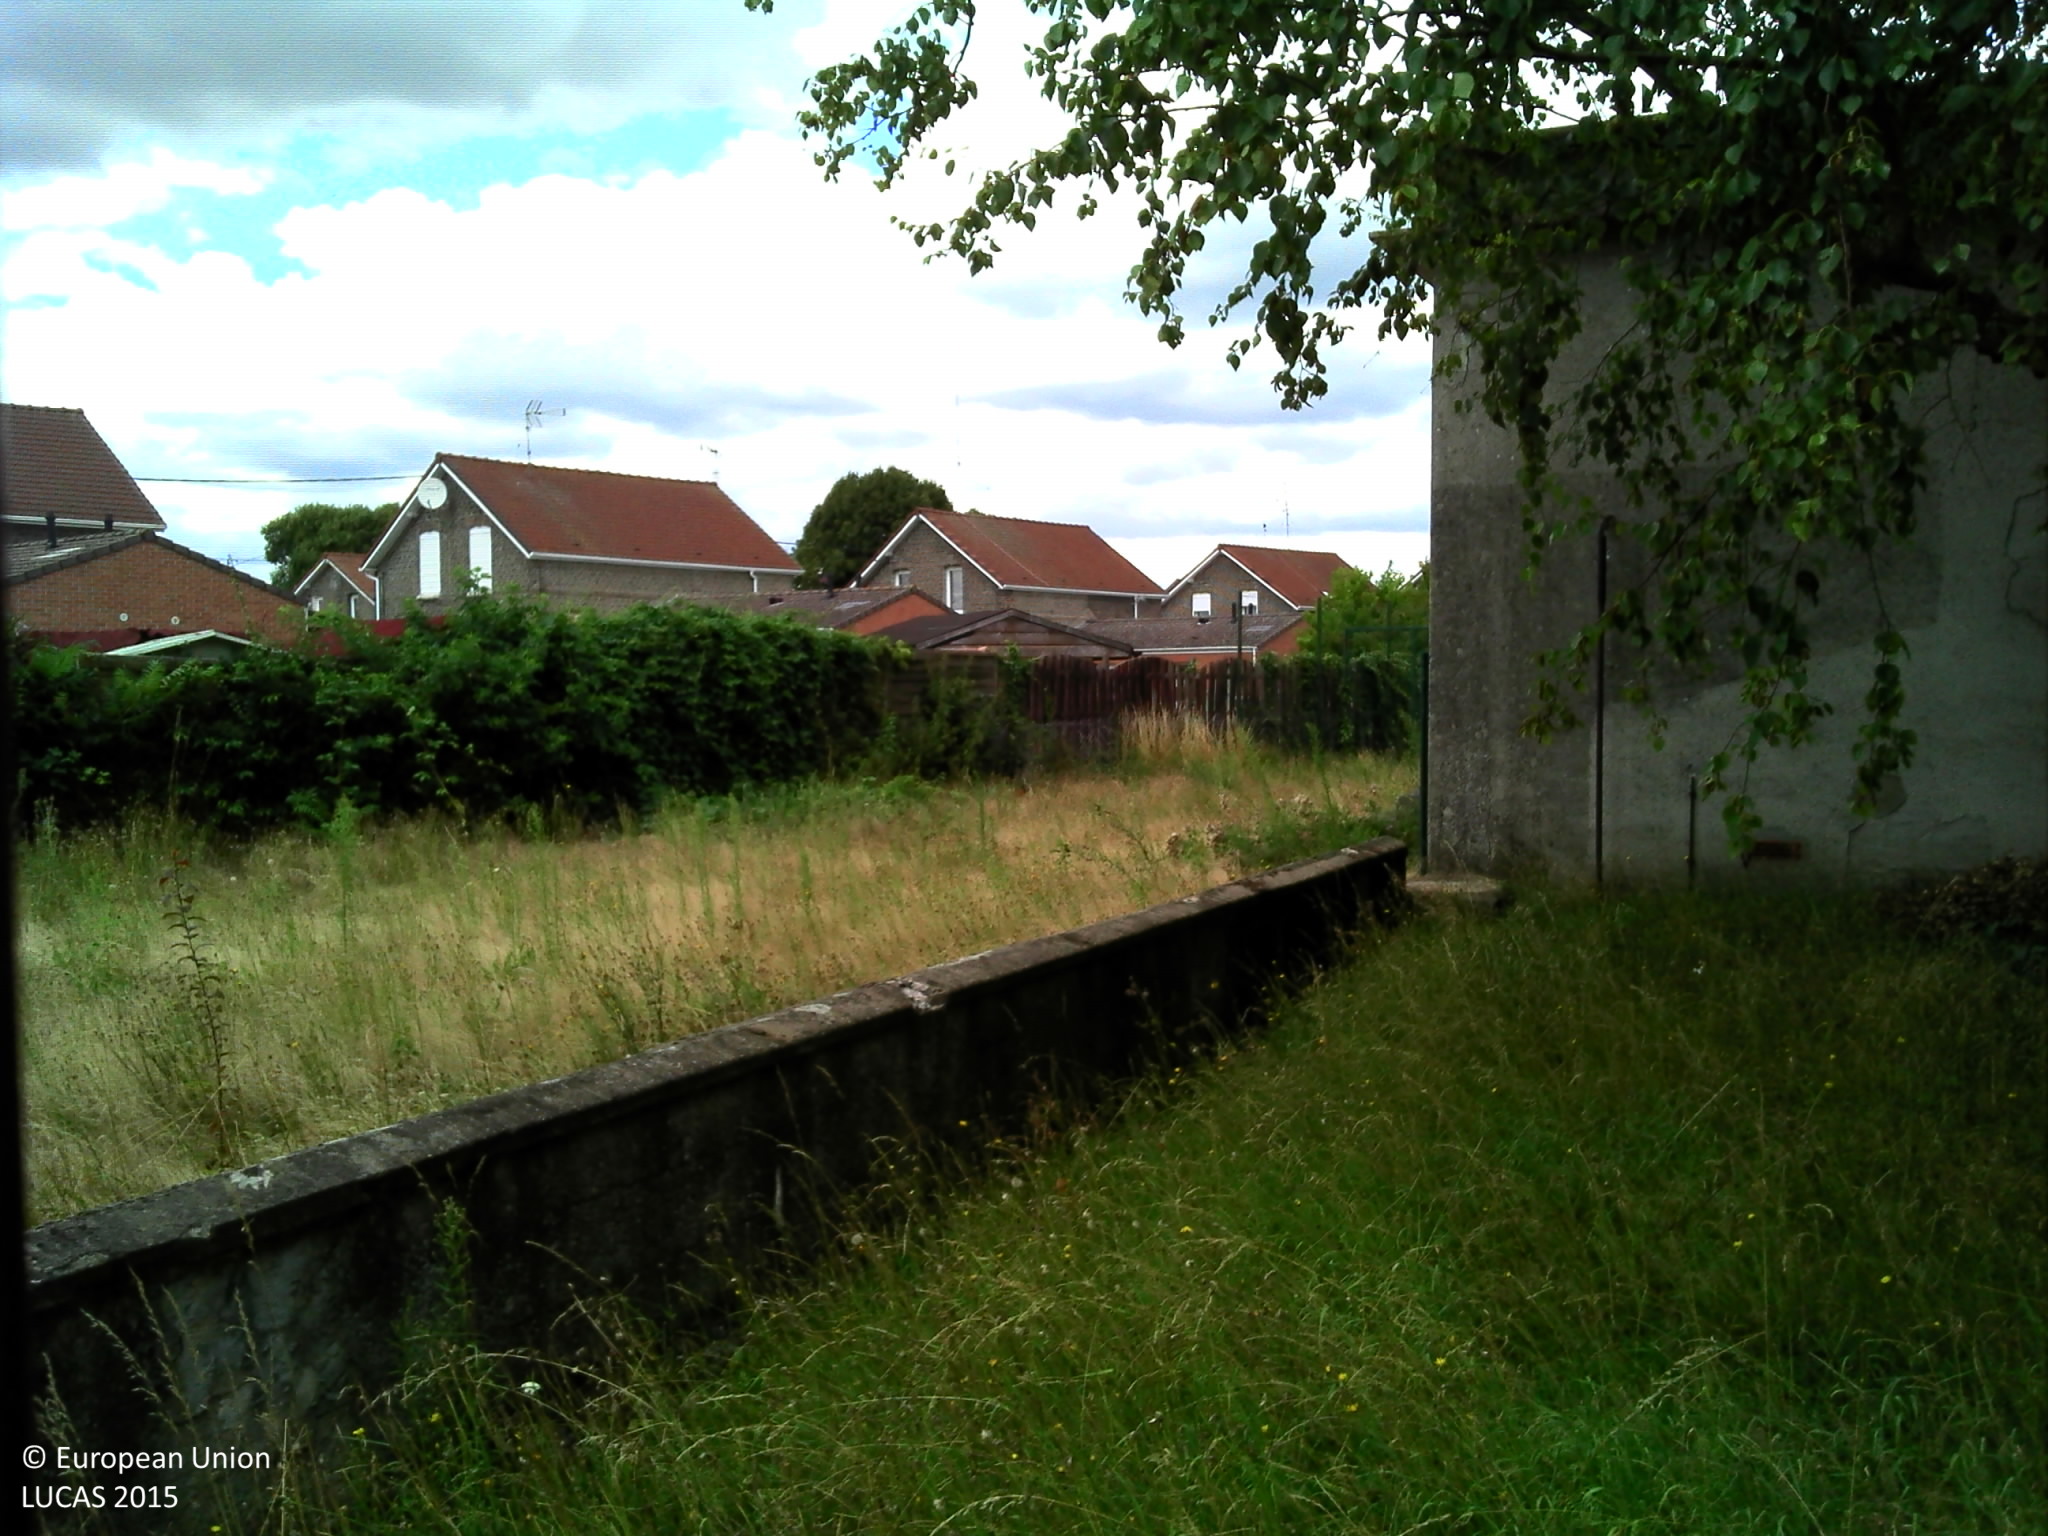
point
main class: Grassland
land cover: Grassland without tree/shrub cover
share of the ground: > 75 %
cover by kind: herbaceous plants 100 %
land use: Community services
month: July
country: FR
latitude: 50.4545
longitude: 3.5841
